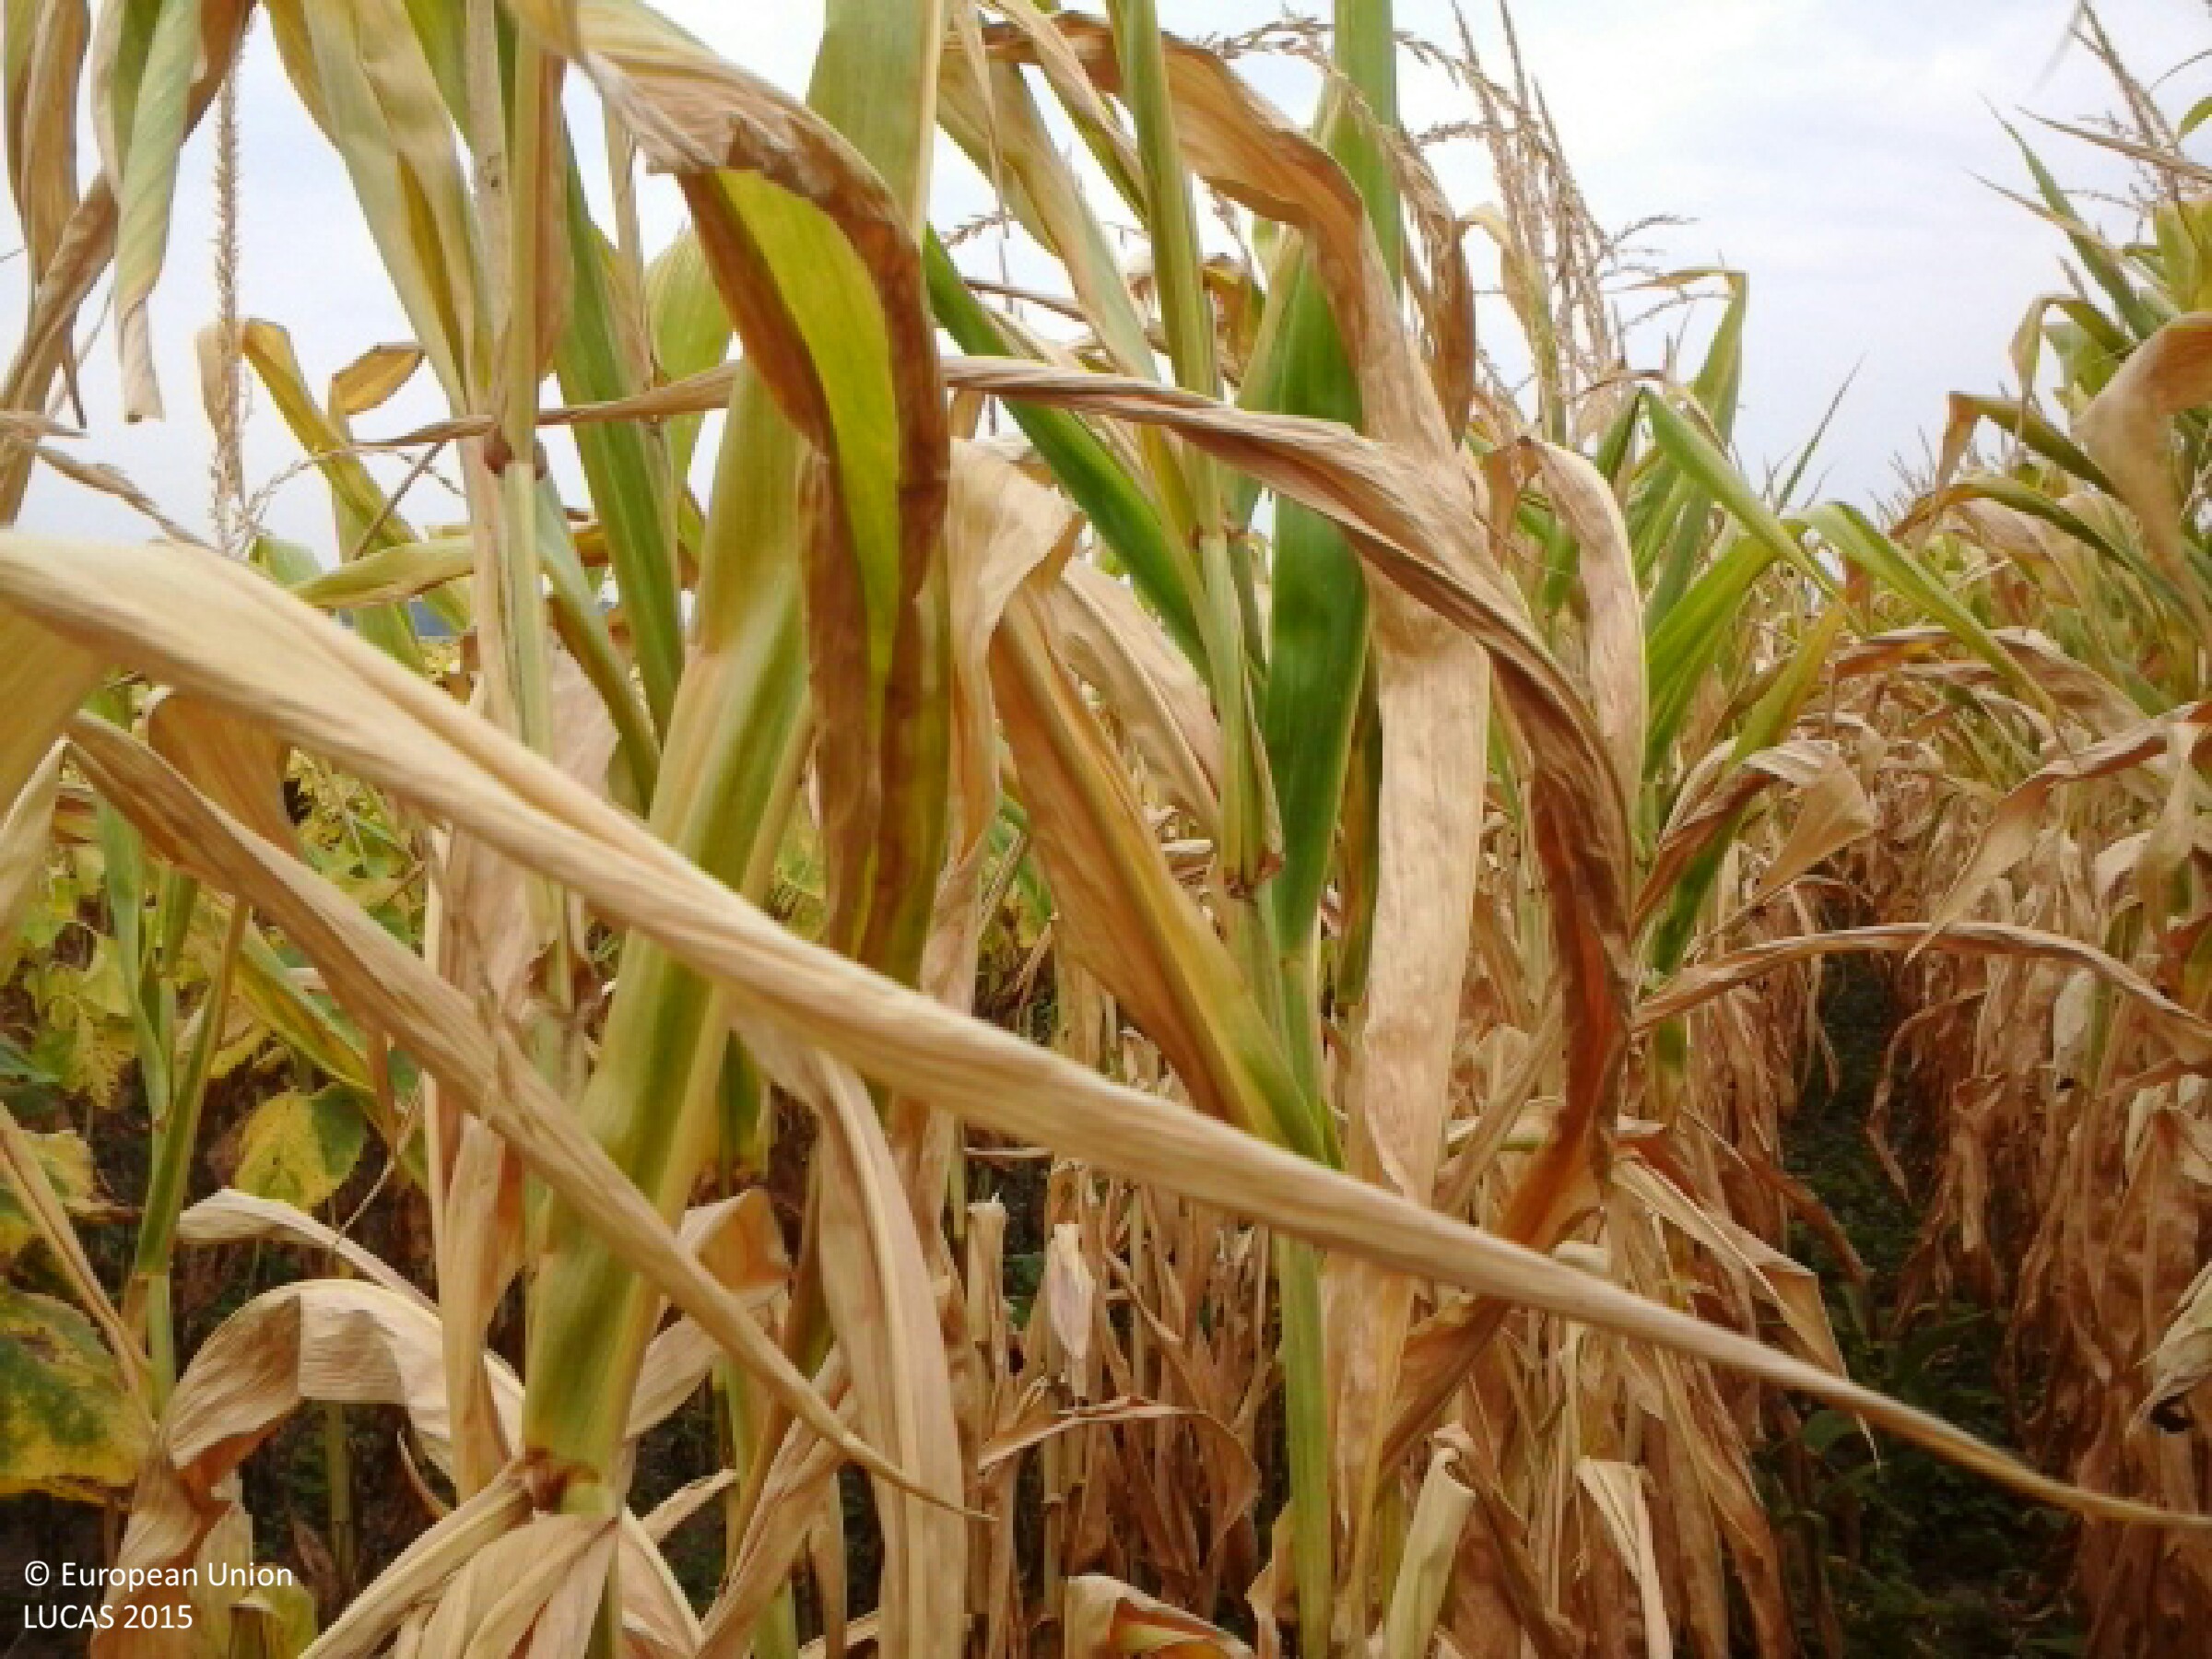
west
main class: Cropland
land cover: Maize
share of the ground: > 75 %
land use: Agriculture (excluding fallow land and kitchen gardens)
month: August
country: HU
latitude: 47.1747
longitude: 21.7477
